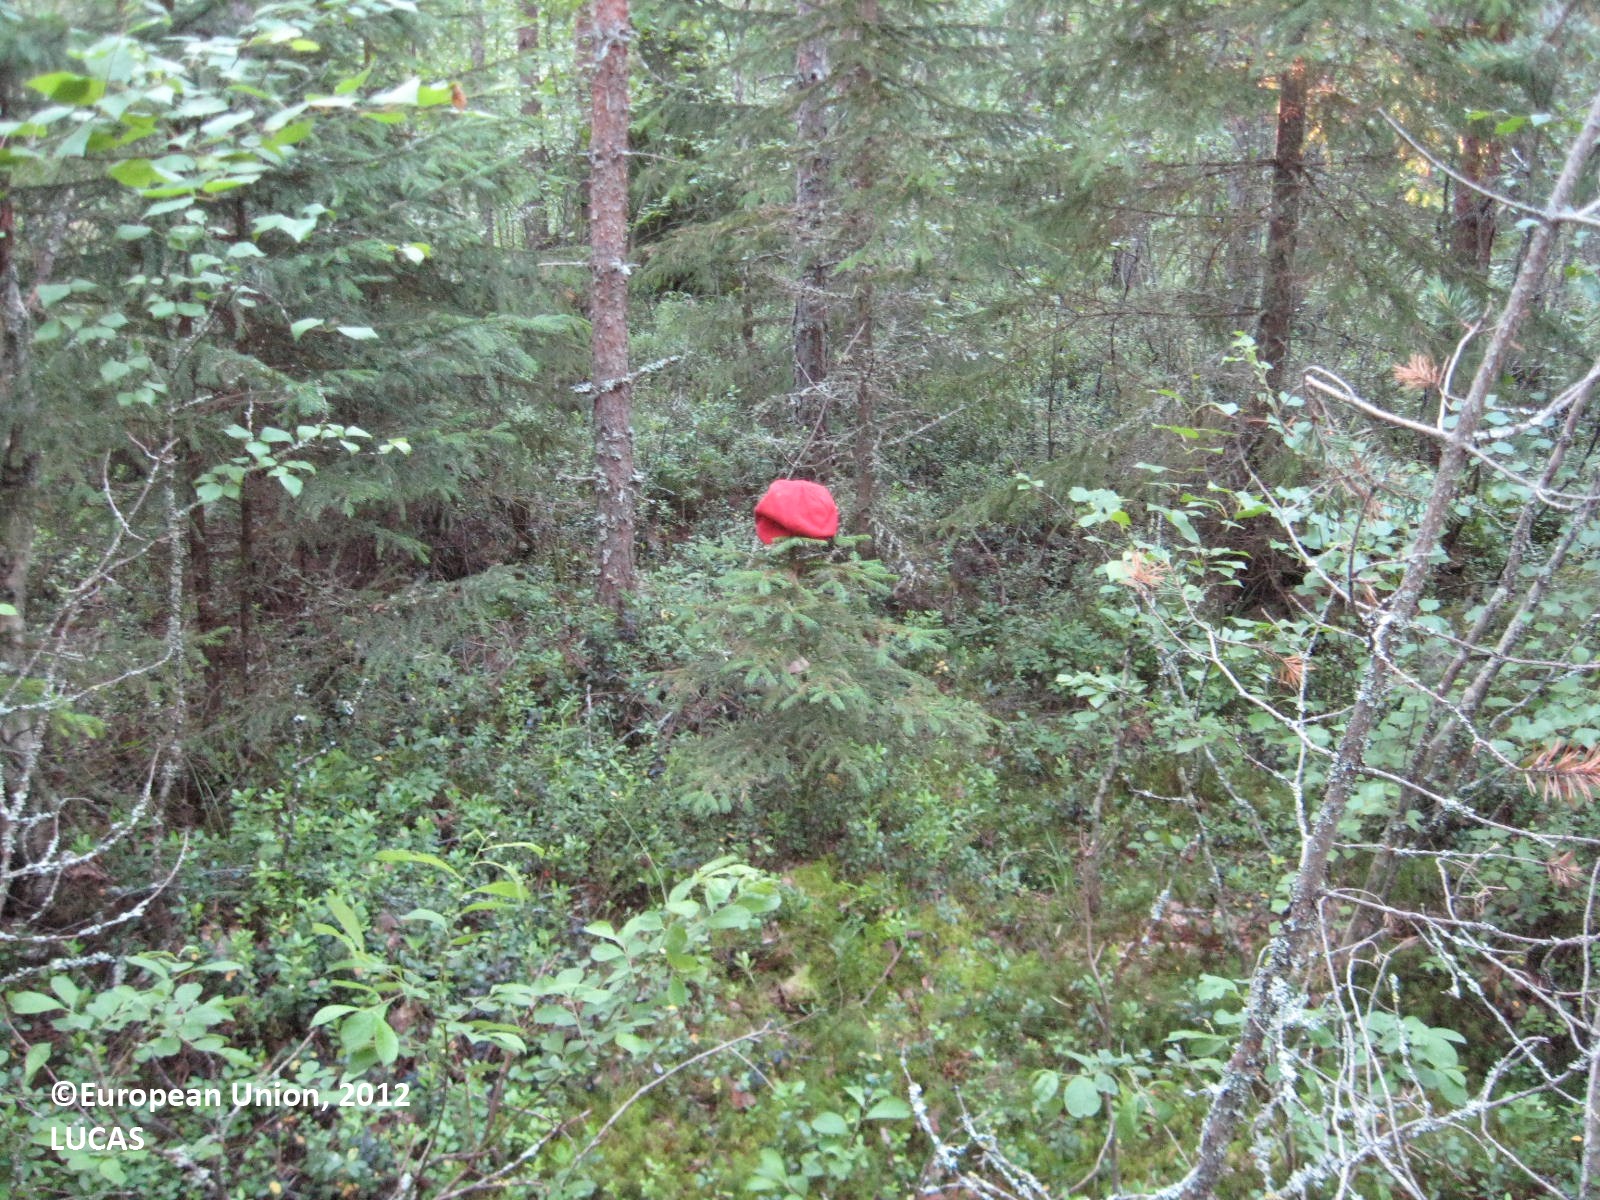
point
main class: Woodland
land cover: Pine dominated mixed woodland
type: boreal forest
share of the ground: > 75 %
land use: Forestry
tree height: > 5 m
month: July
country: FI
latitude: 62.4179
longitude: 21.6027
